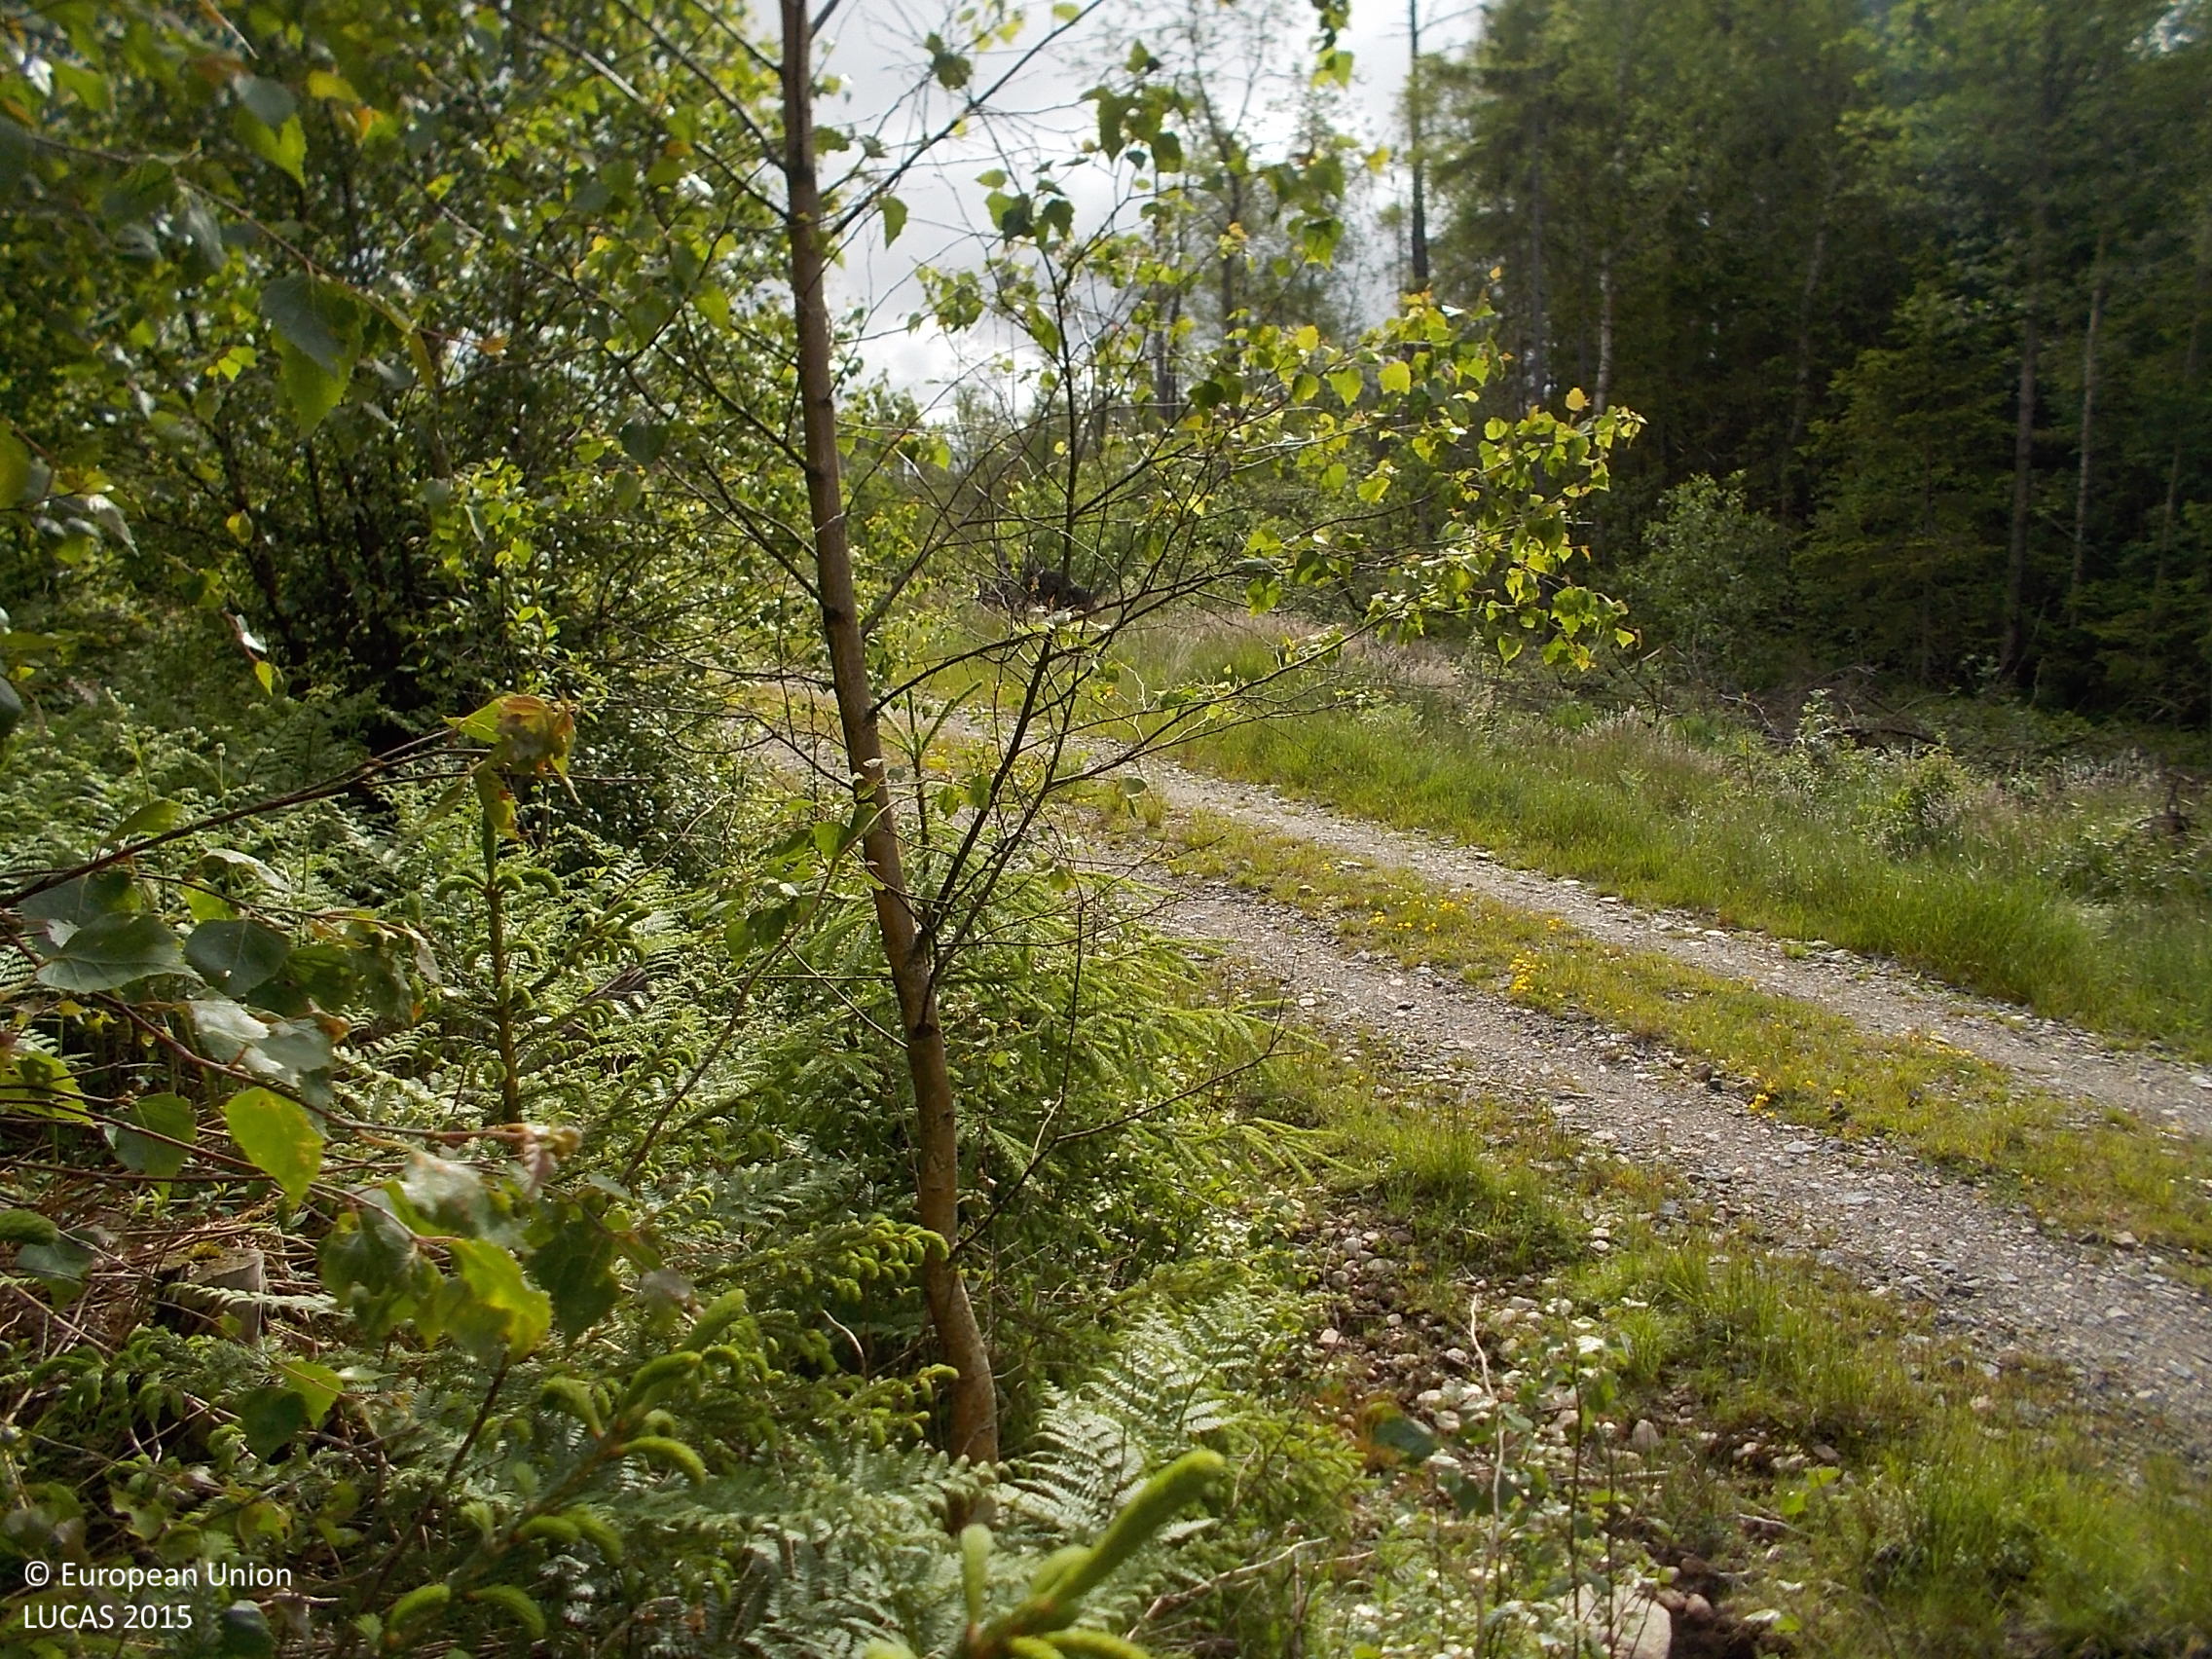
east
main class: Woodland
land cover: Broadleaved woodland
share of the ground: > 75 %
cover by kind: broadleaved forest trees 70 %, herbaceous plants 10 %, lichens and mosses 10 %, coniferous forest trees 5 %, shrubs 5 %
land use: Forestry
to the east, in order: Broadleaved woodland; Ditches and canals; Tracks; Shrubland with sparse tree cover; Grassland with sparse tree/shrub cover; Shrubland with sparse tree cover; Grassland with sparse tree/shrub cover
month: June
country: SE
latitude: 57.1103
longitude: 12.8199
